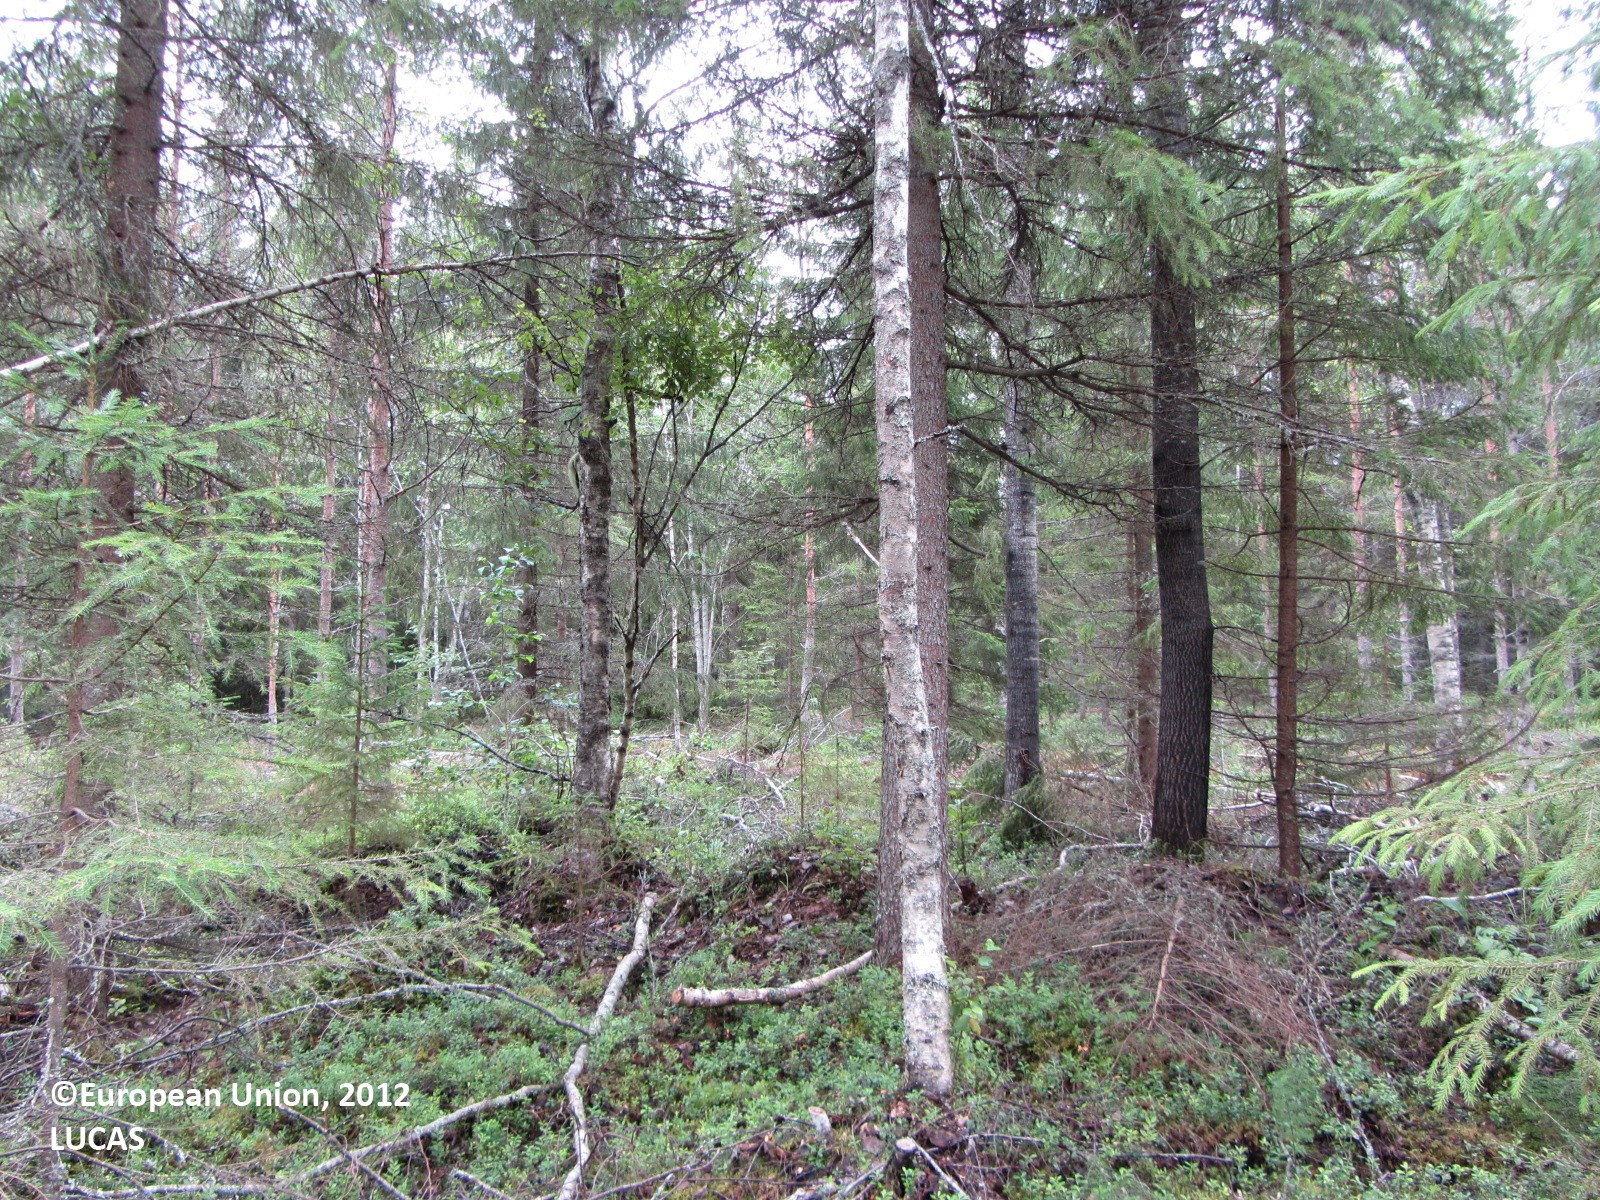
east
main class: Woodland
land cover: Other mixed woodland
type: boreal forest
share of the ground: 50 - 75 %
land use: Forestry
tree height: > 5 m
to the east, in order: Other mixed woodland; Ditches and canals; Other coniferous woodland; Spruce dominated coniferous woodland; Spruce dominated mixed woodland; Ditches and canals; Spruce dominated mixed woodland; Shrubland with sparse tree cover; Other coniferous woodland
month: July
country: FI
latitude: 63.8905
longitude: 24.7236
